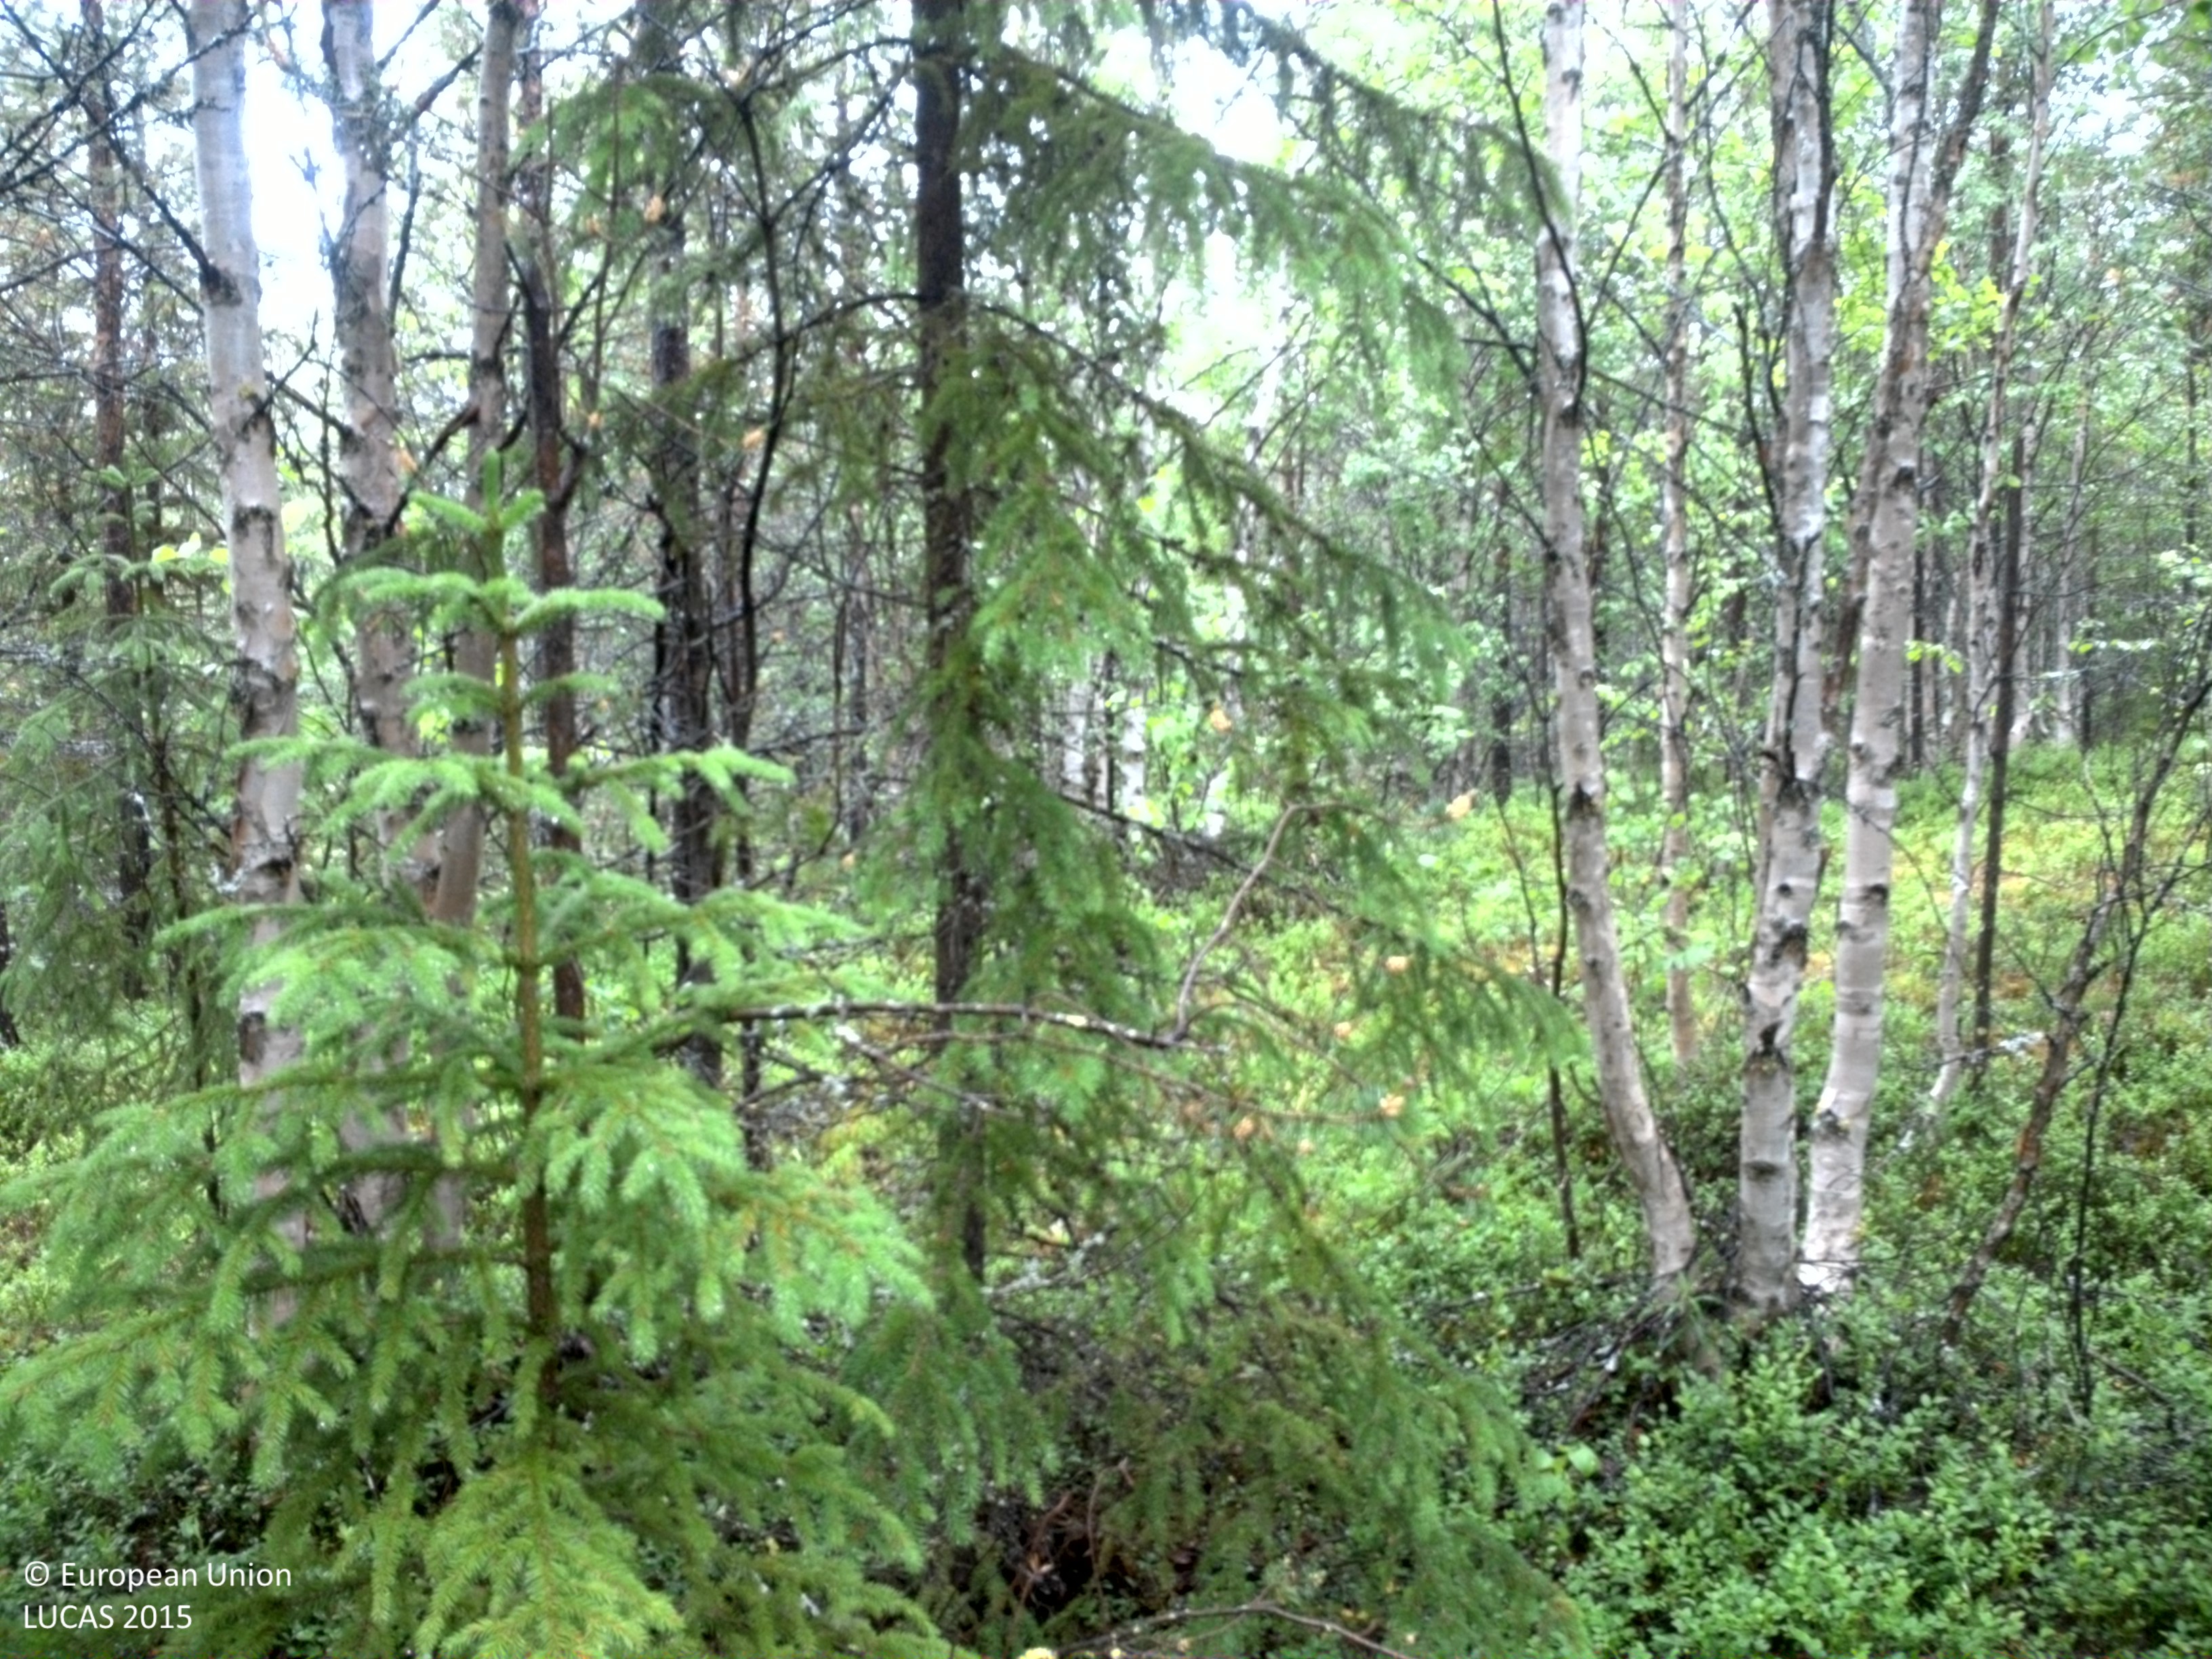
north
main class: Woodland
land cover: Other mixed woodland
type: boreal forest
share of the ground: 50 - 75 %
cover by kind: coniferous forest trees 45 %, shrubs 30 %, broadleaved forest trees 15 %, lichens and mosses 10 %
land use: Forestry
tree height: > 5 m
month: July
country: SE
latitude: 64.5892
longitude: 18.1336
